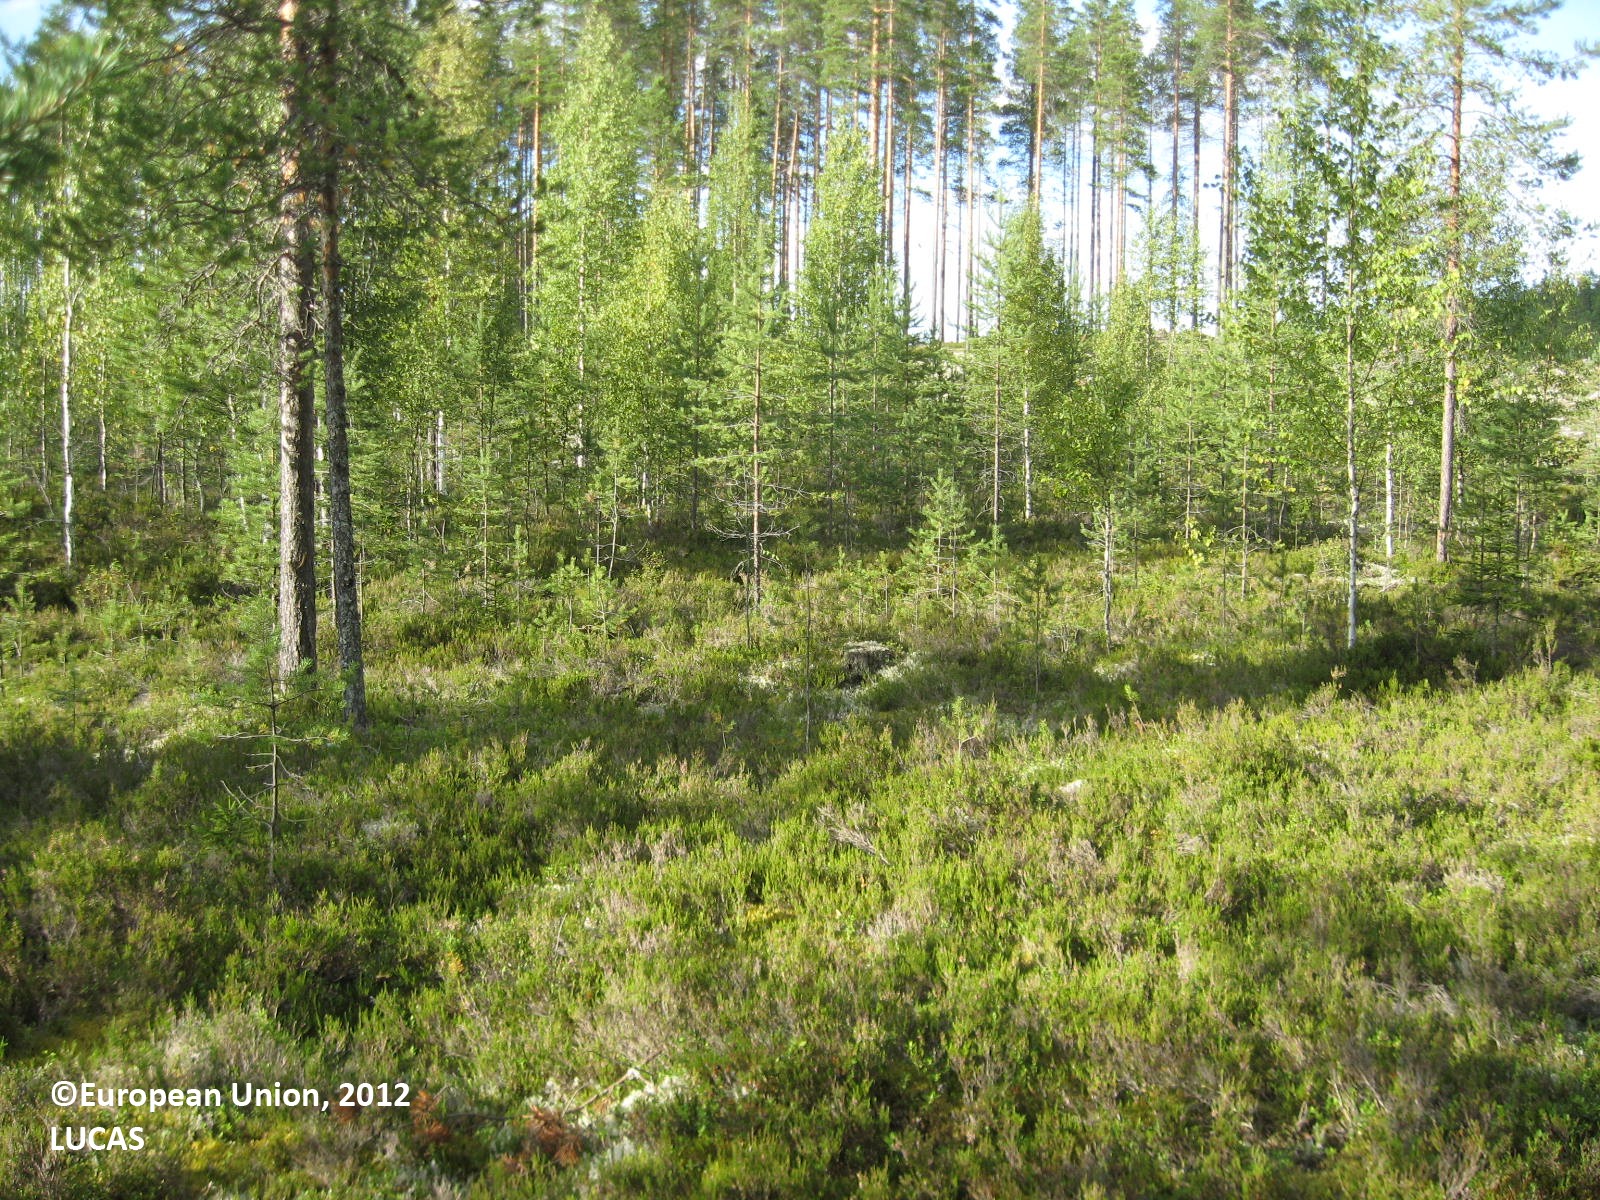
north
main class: Woodland
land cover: Pine dominated coniferous woodland
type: boreal forest
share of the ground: > 75 %
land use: Forestry
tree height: > 5 m
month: August
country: FI
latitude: 63.5988
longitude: 29.6433
